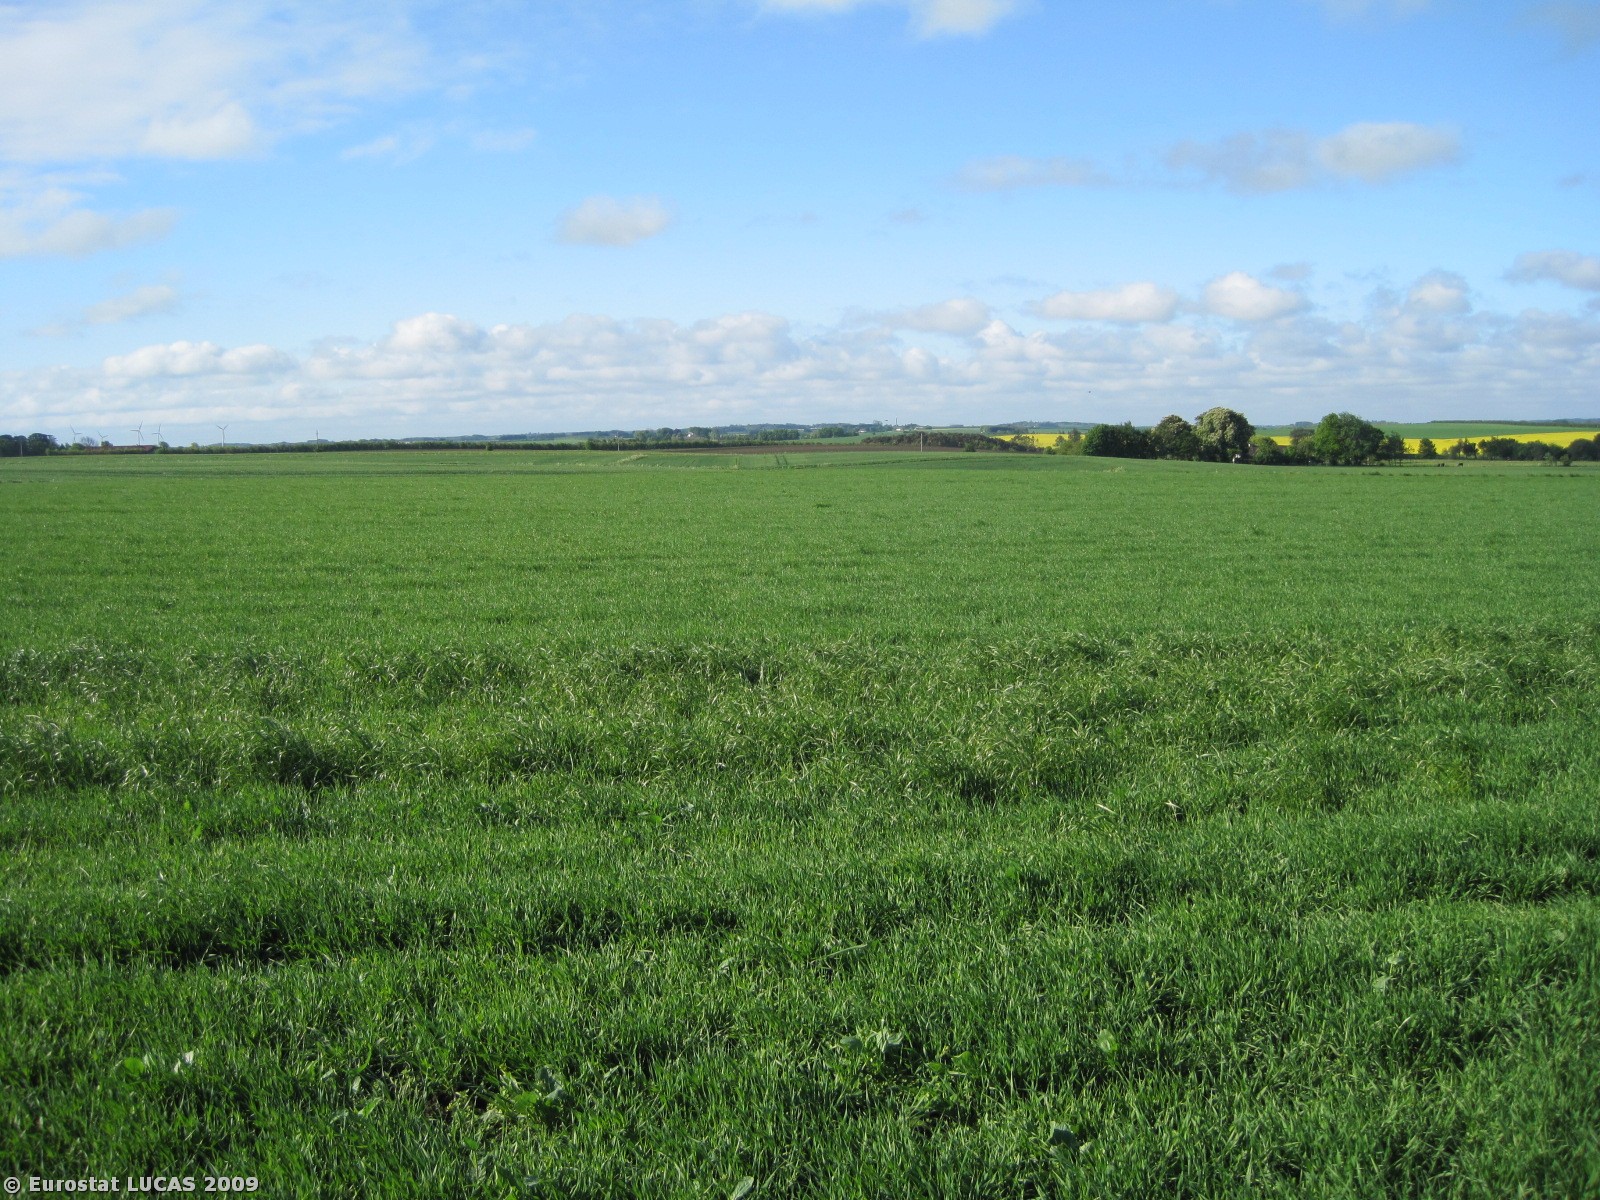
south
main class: Cropland
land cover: Barley
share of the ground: > 75 %
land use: Agriculture (excluding fallow land and kitchen gardens)
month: May
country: DK
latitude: 56.8888
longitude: 9.9836
